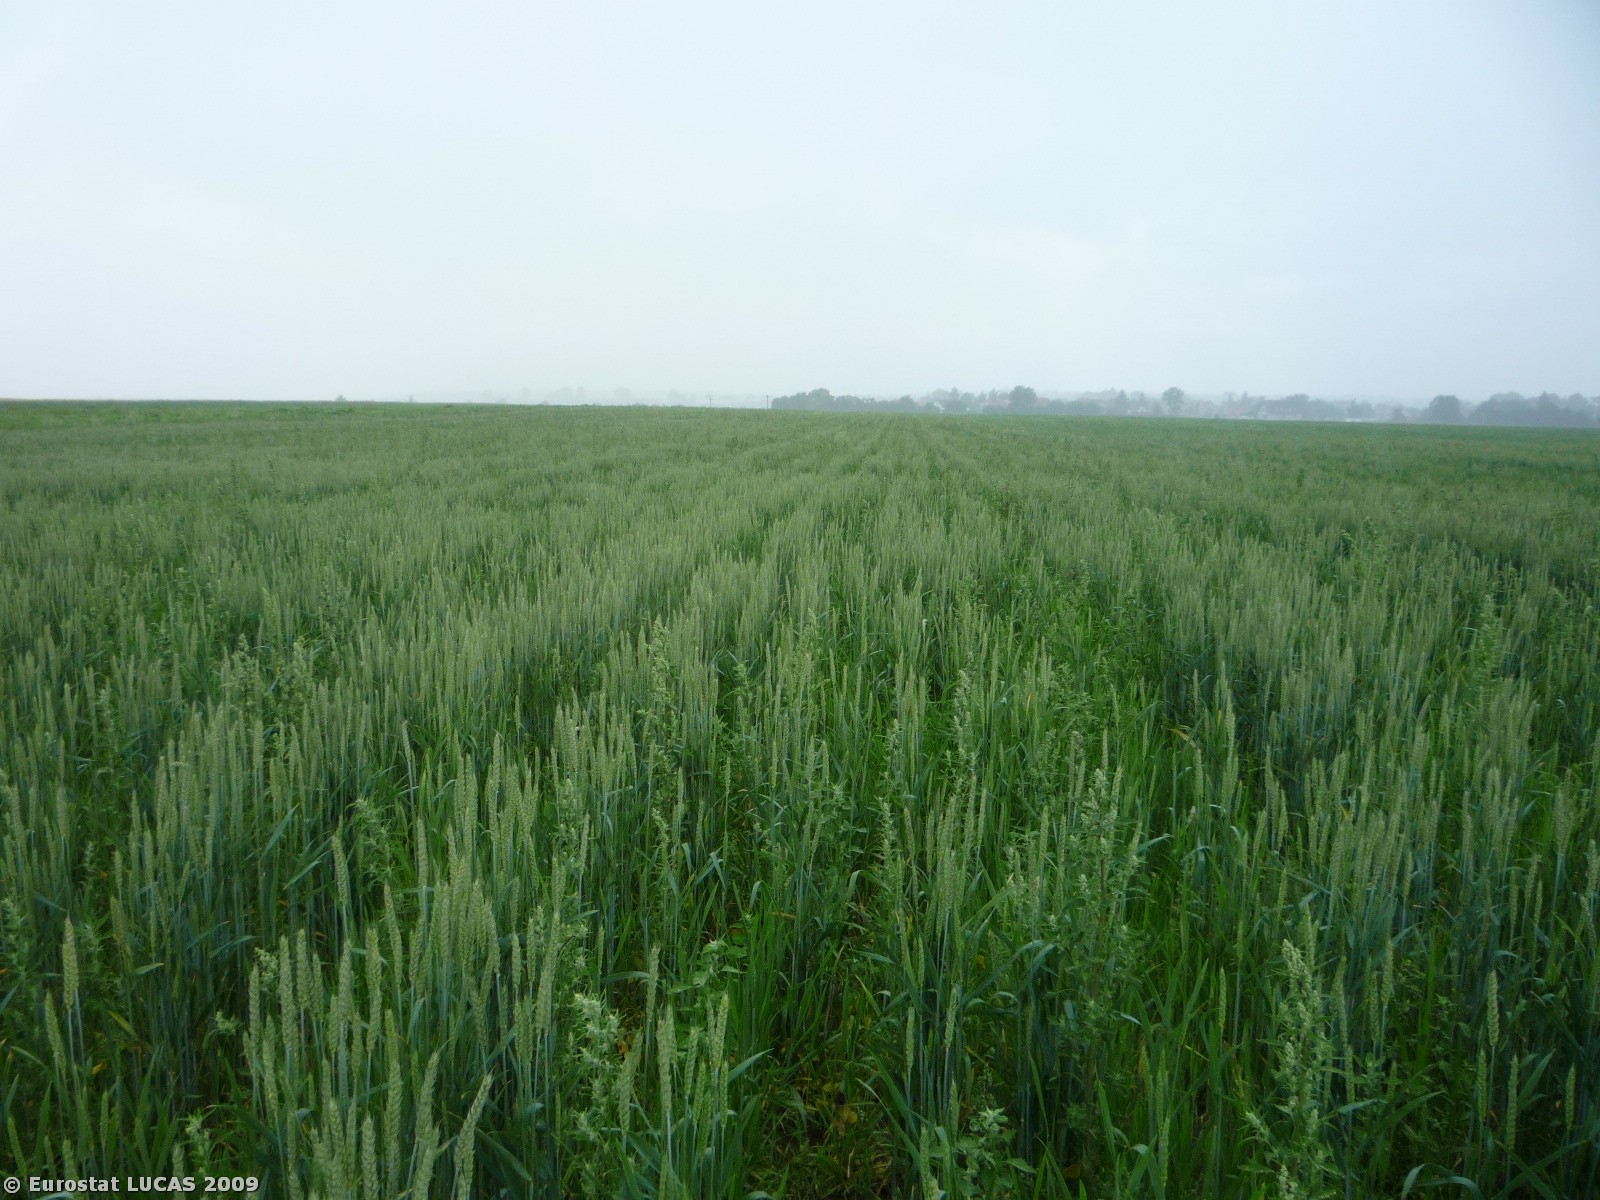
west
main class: Cropland
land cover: Common wheat
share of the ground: > 75 %
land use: Agriculture (excluding fallow land and kitchen gardens)
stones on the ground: < 10 %
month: June
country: CZ
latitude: 50.1415
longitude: 15.5031
